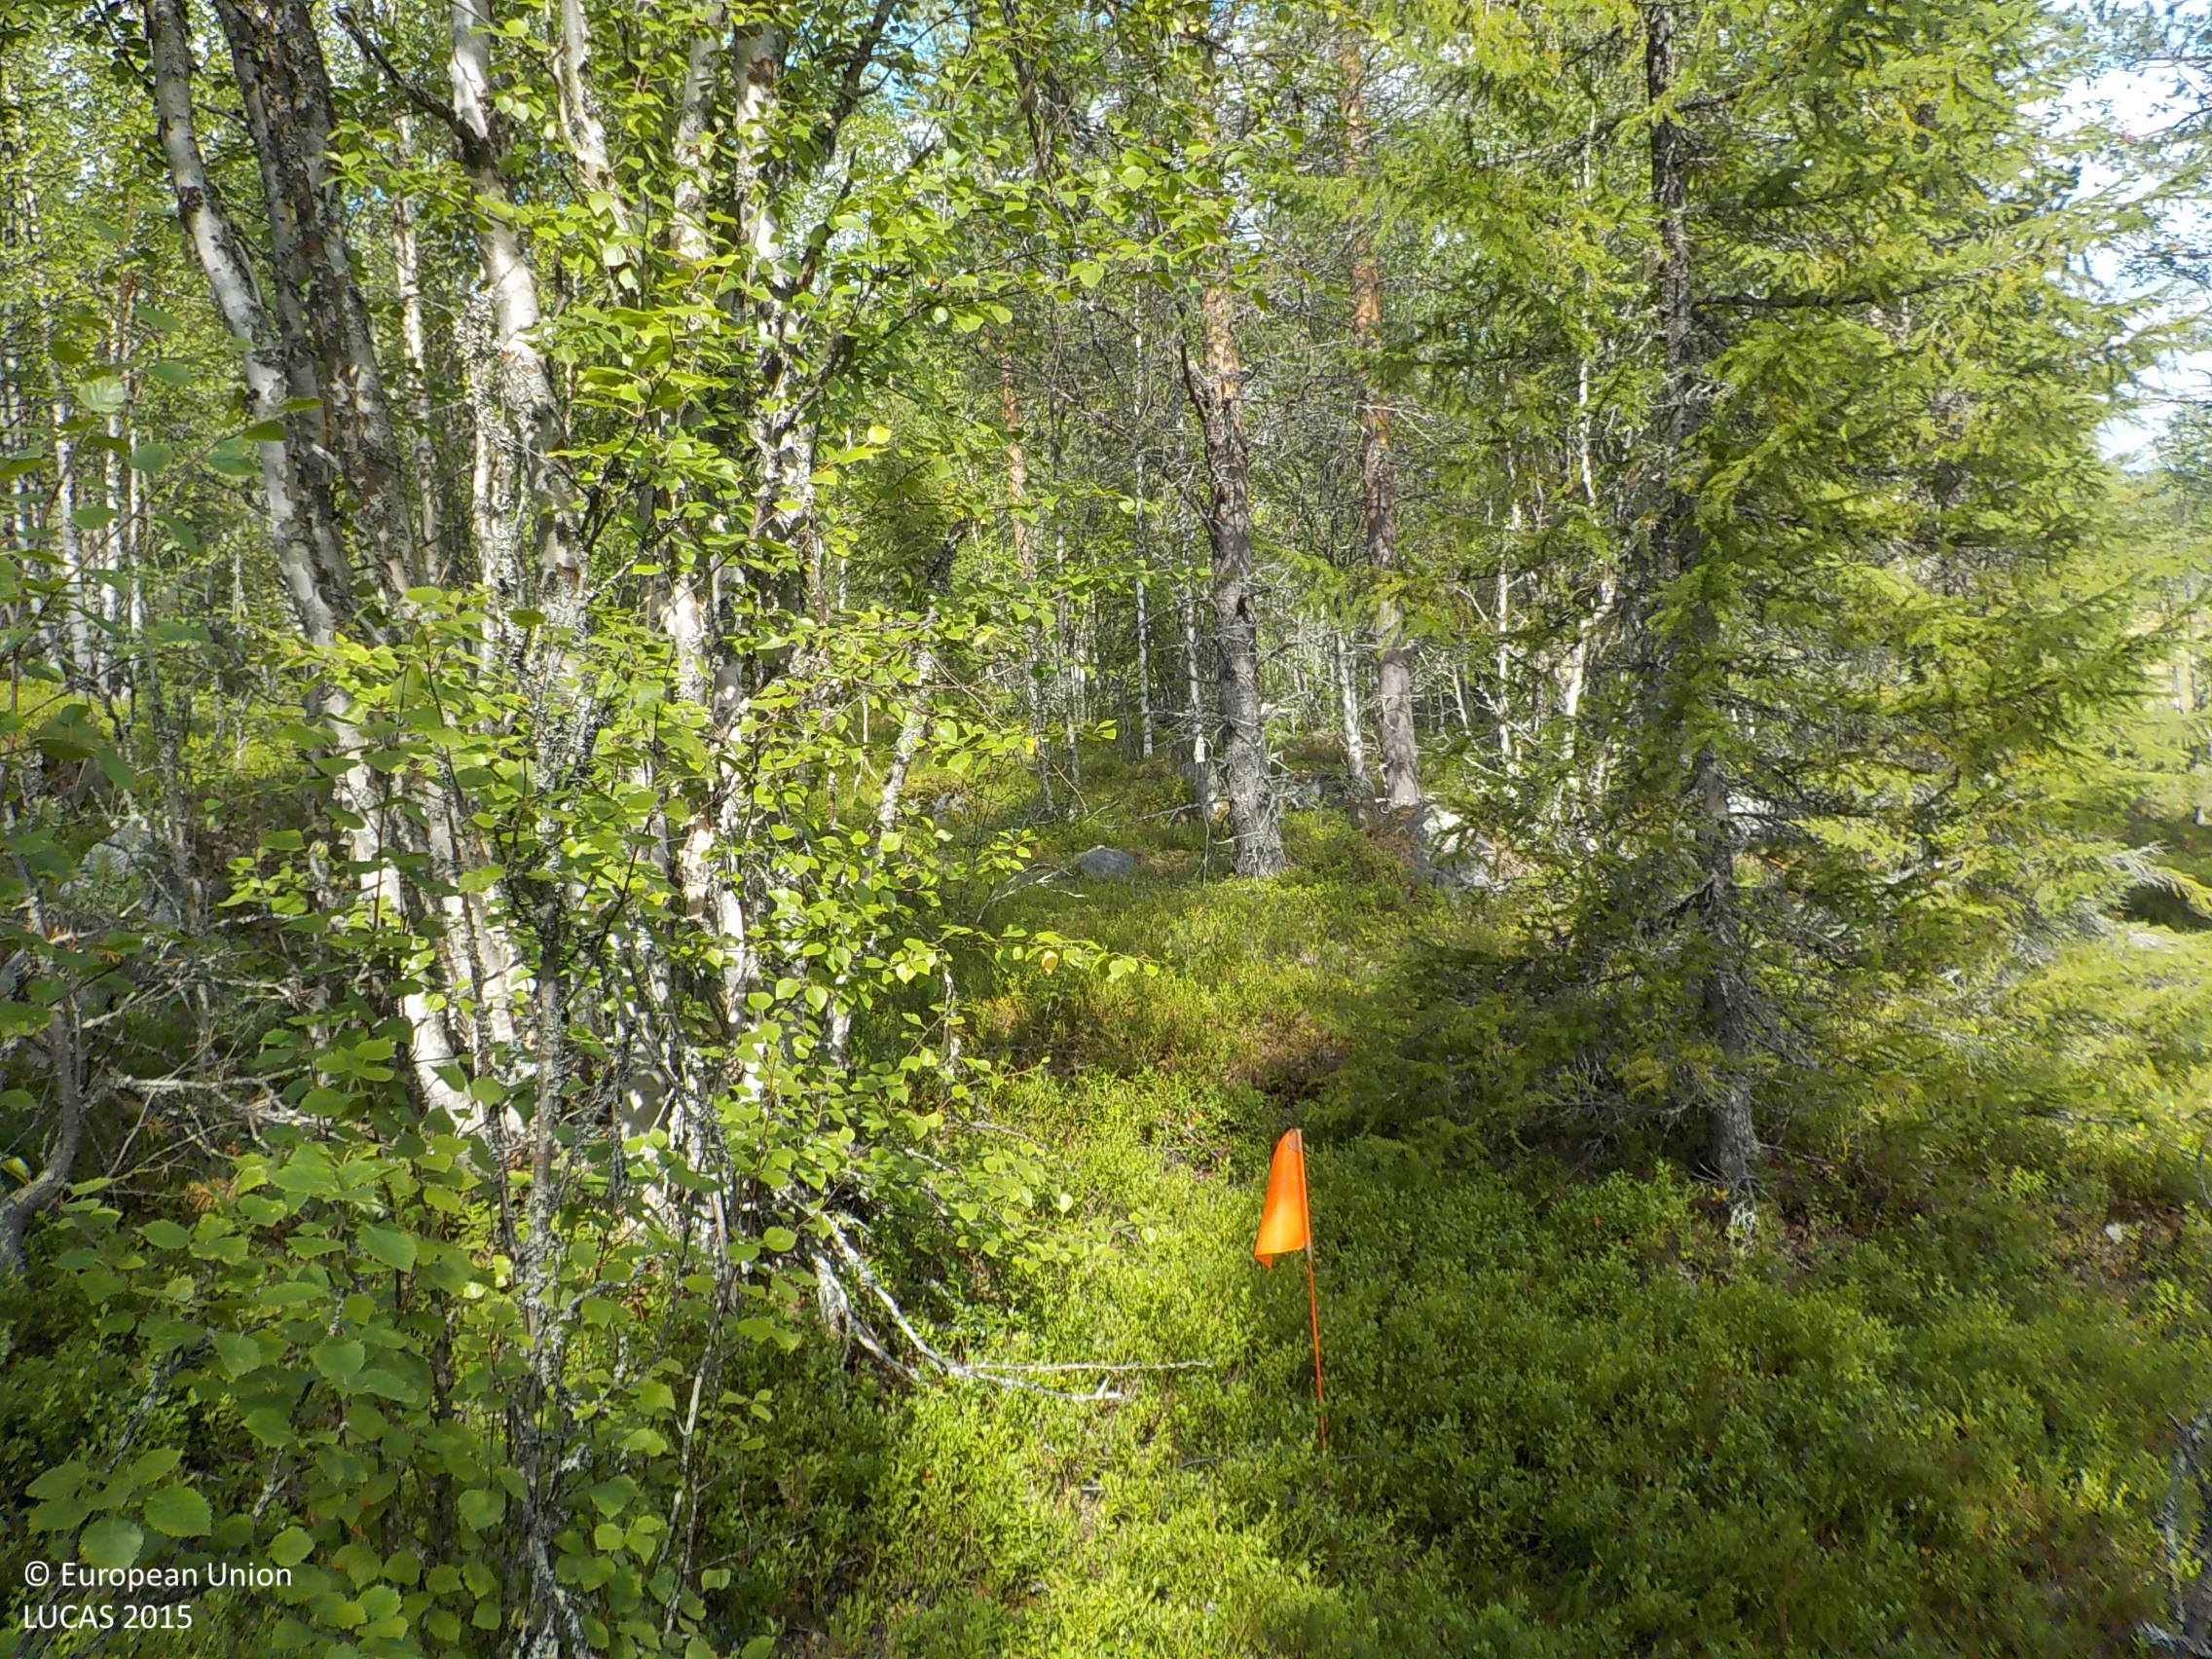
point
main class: Woodland
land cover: Pine dominated mixed woodland
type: boreal forest
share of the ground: > 75 %
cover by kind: coniferous forest trees 50 %, broadleaved forest trees 30 %, shrubs 20 %
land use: Forestry
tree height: > 5 m
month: August
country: SE
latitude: 64.0680
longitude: 17.6562
